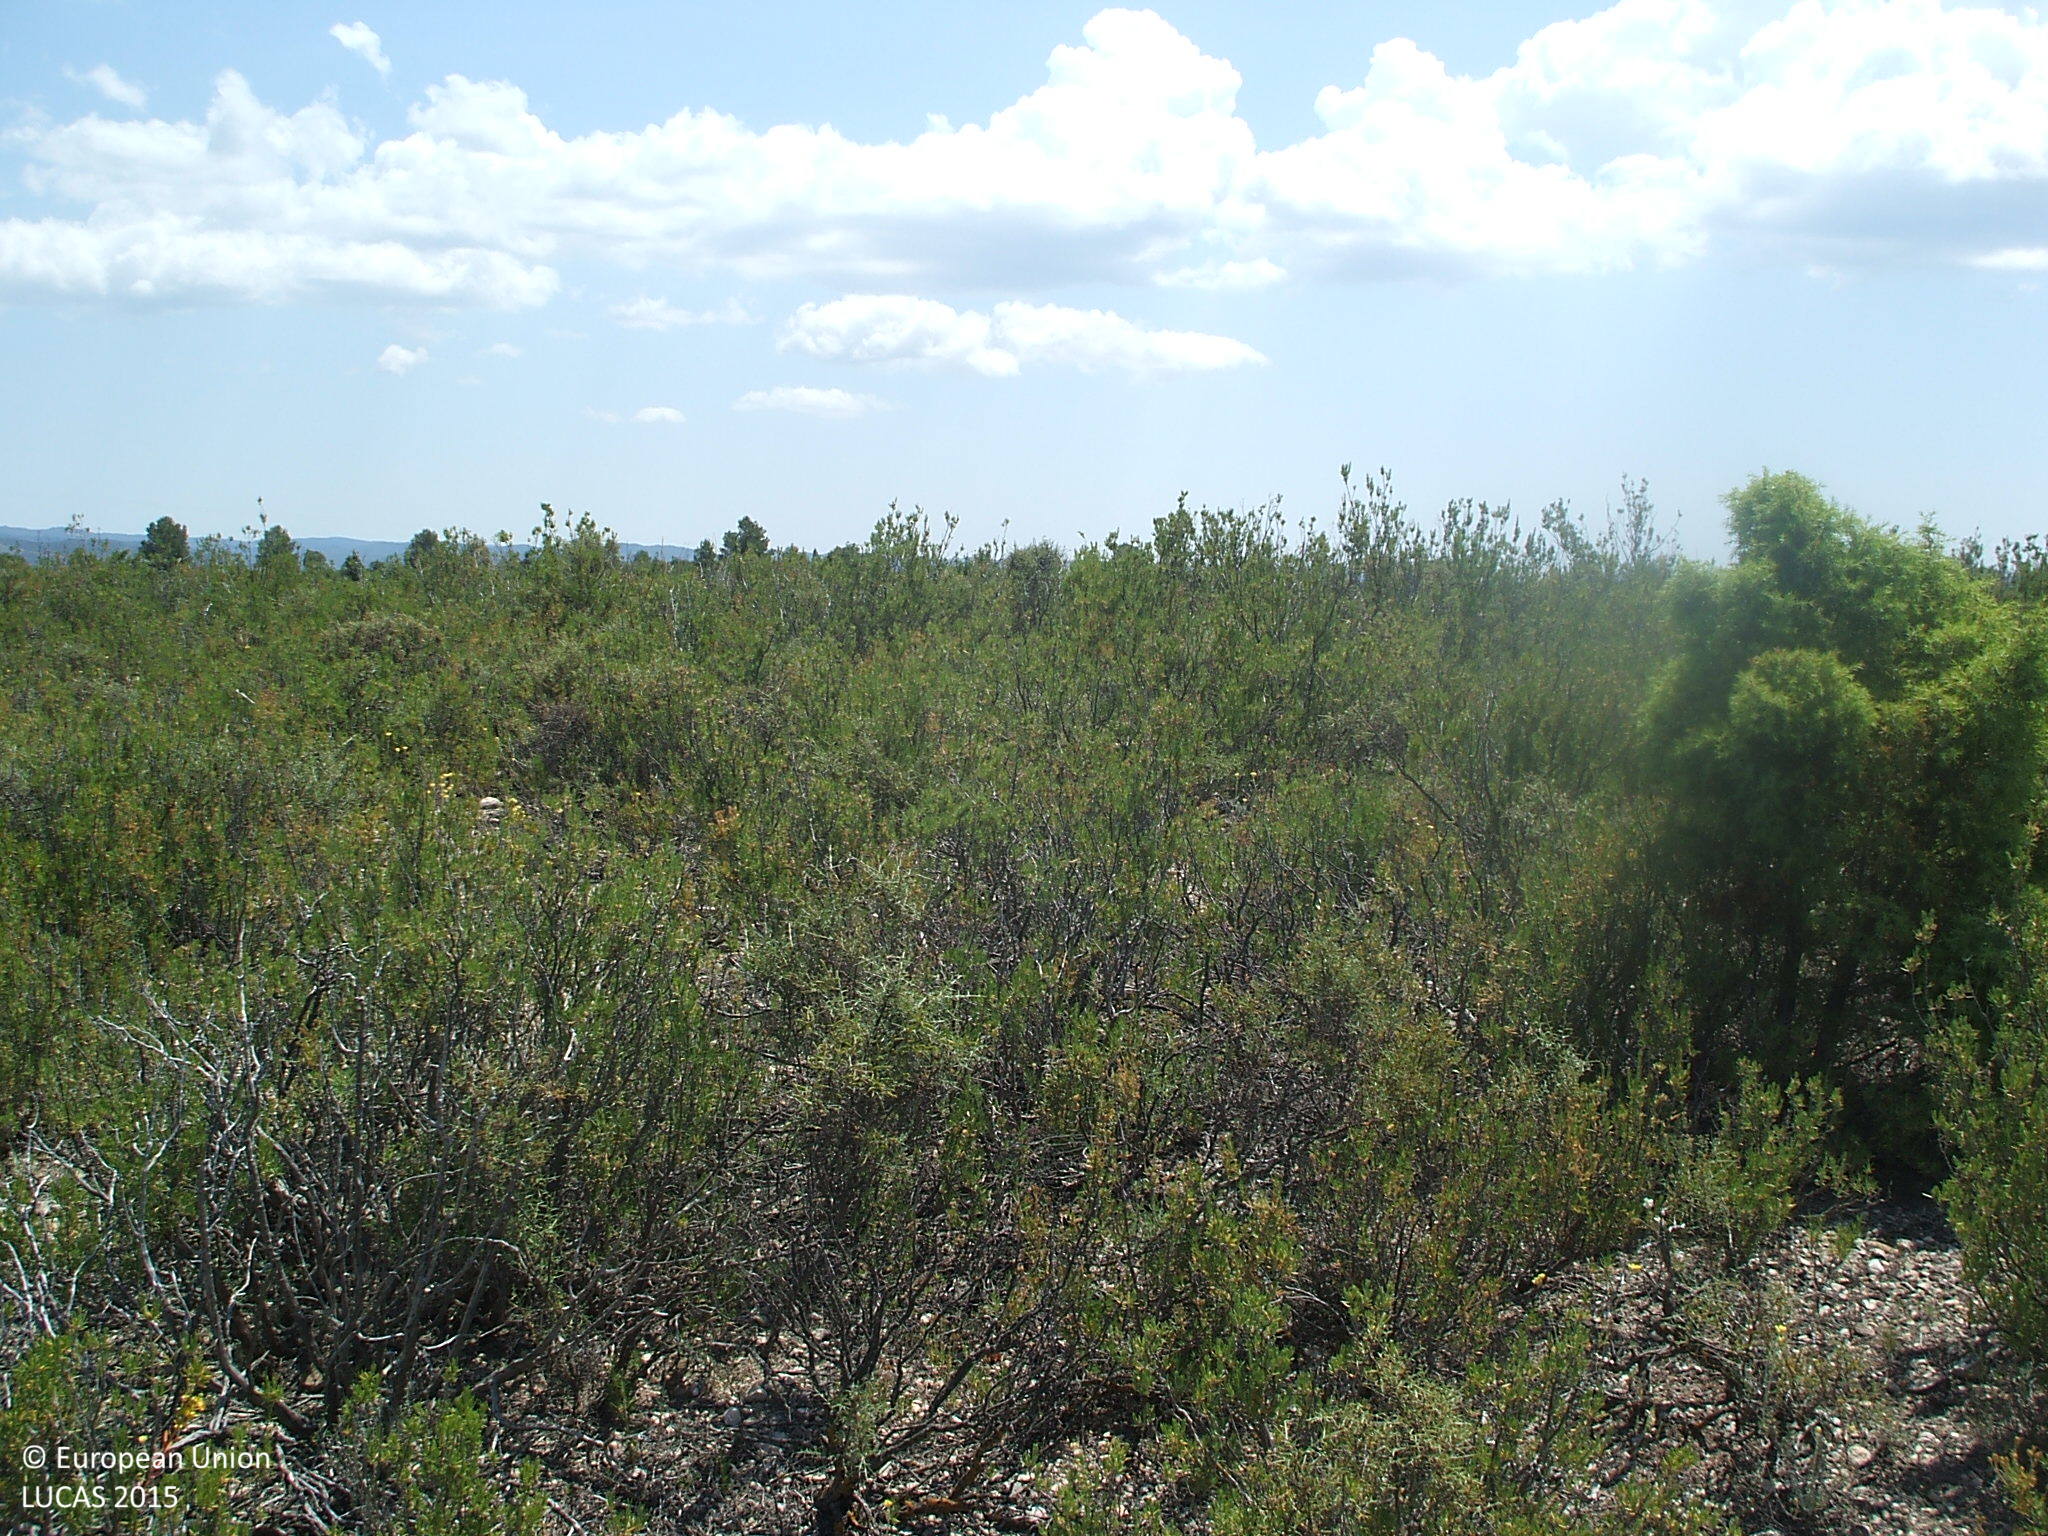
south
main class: Shrubland
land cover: Shrubland with sparse tree cover
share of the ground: > 75 %
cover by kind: shrubs 80 %, consolidated bare surface 15 %, coniferous forest trees 5 %
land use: Semi-natural and natural areas not in use
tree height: > 5 m
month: June
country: ES
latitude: 40.8254
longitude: -0.2189
